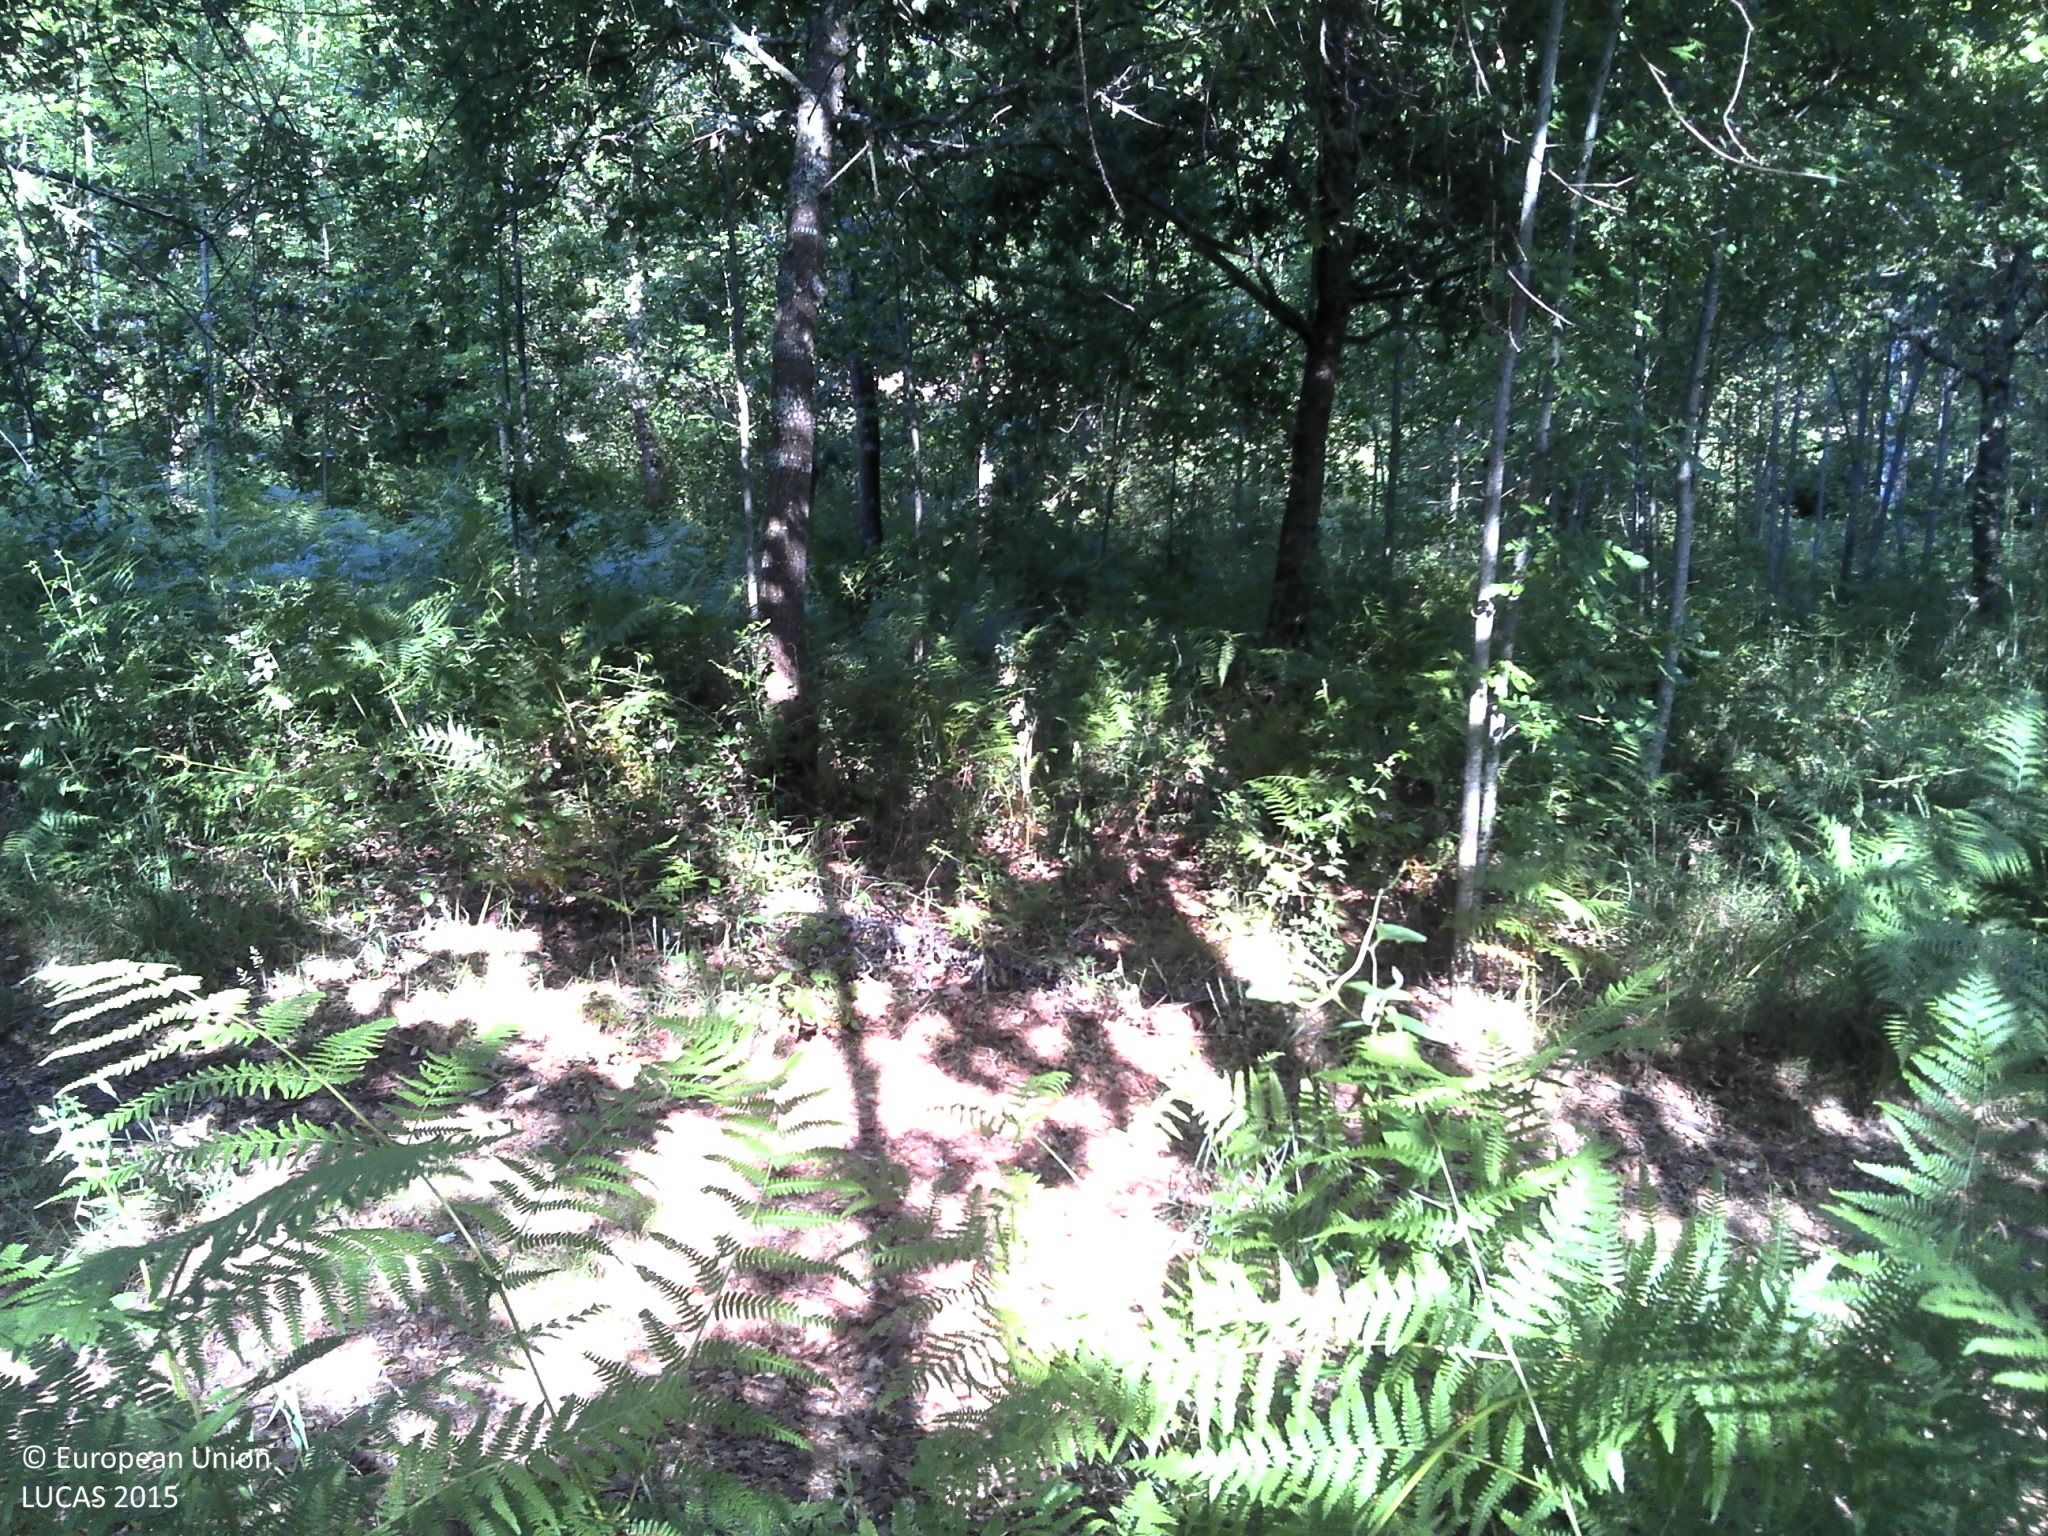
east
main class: Woodland
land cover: Broadleaved woodland
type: thermophilous deciduous forest
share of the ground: 25 - 50 %
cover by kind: unconsolidated bare surface 40 %, broadleaved forest trees 30 %, shrubs 30 %
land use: Forestry
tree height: > 5 m
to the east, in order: Broadleaved woodland; Tracks; Broadleaved woodland; Electric lines; Broadleaved woodland; Paved roads, cycling and walking lanes; Pine dominated coniferous woodland; Tracks; Pine dominated coniferous woodland
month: June
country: PT
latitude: 39.9617
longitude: -8.1586
